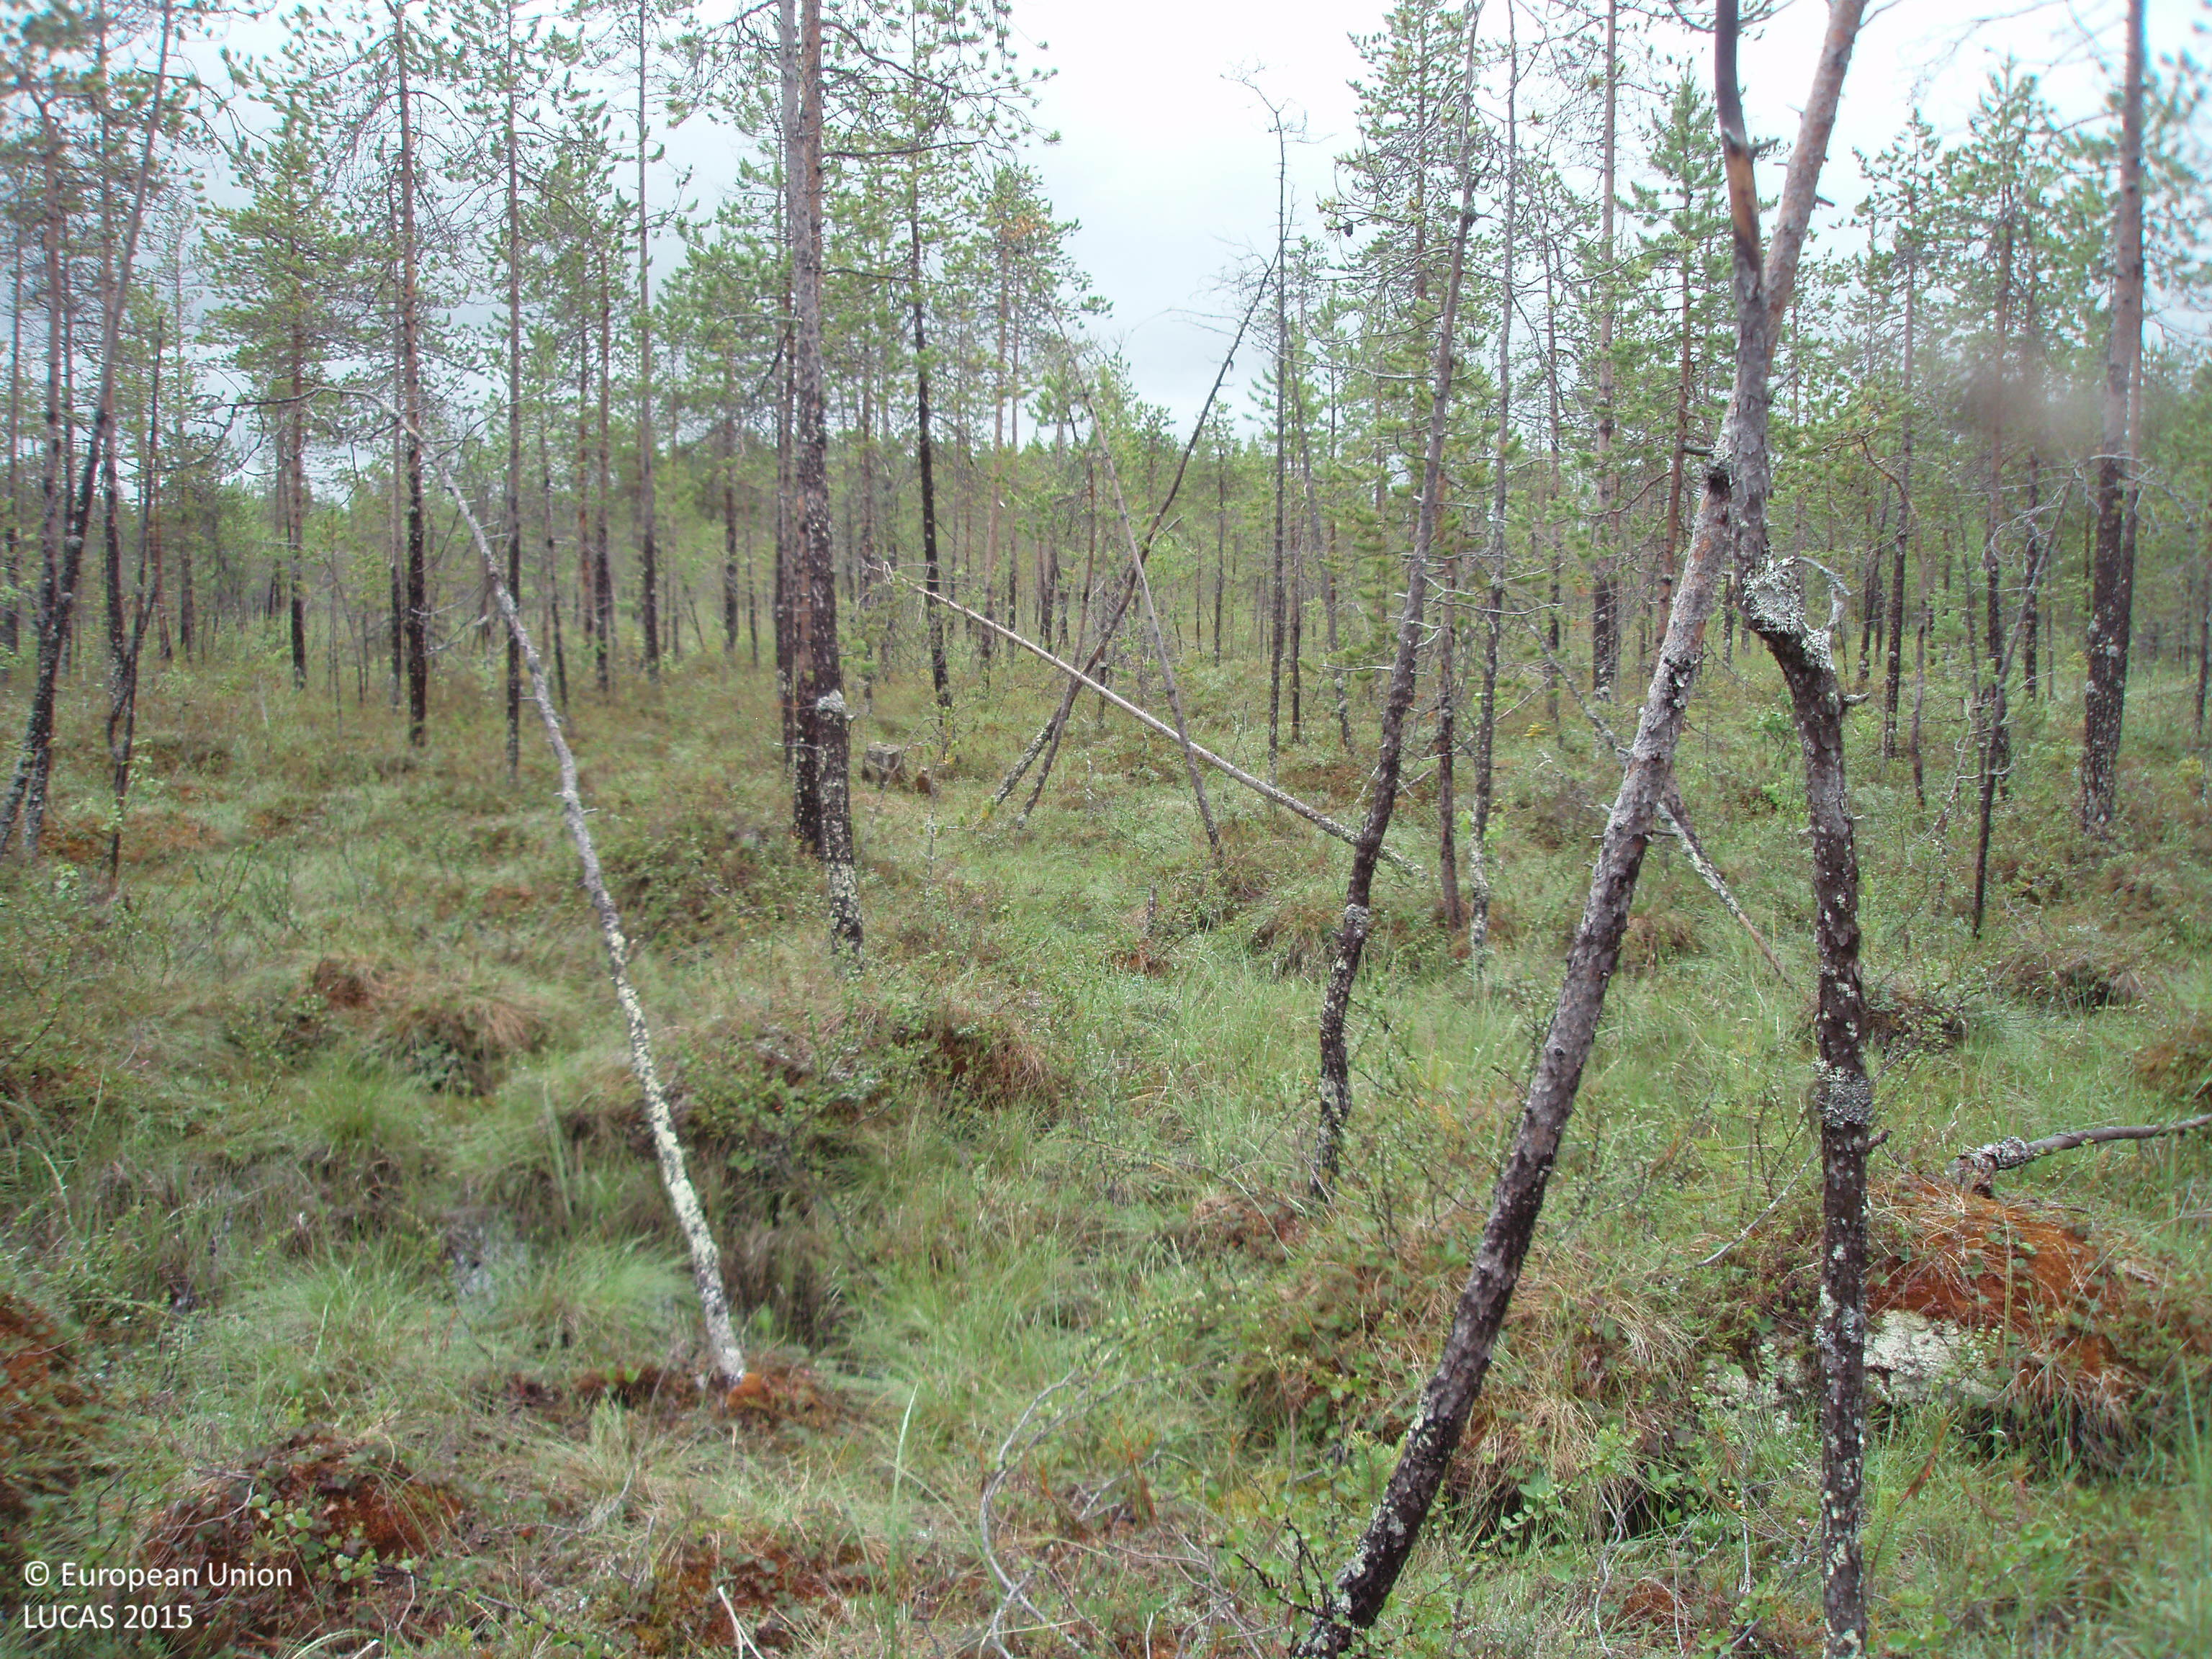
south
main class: Woodland
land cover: Pine dominated coniferous woodland
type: mire and swamp forests
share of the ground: 25 - 50 %
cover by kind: shrubs 70 %, coniferous forest trees 30 %
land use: Semi-natural and natural areas not in use
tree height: > 5 m
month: July
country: FI
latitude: 67.1717
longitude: 28.6403
